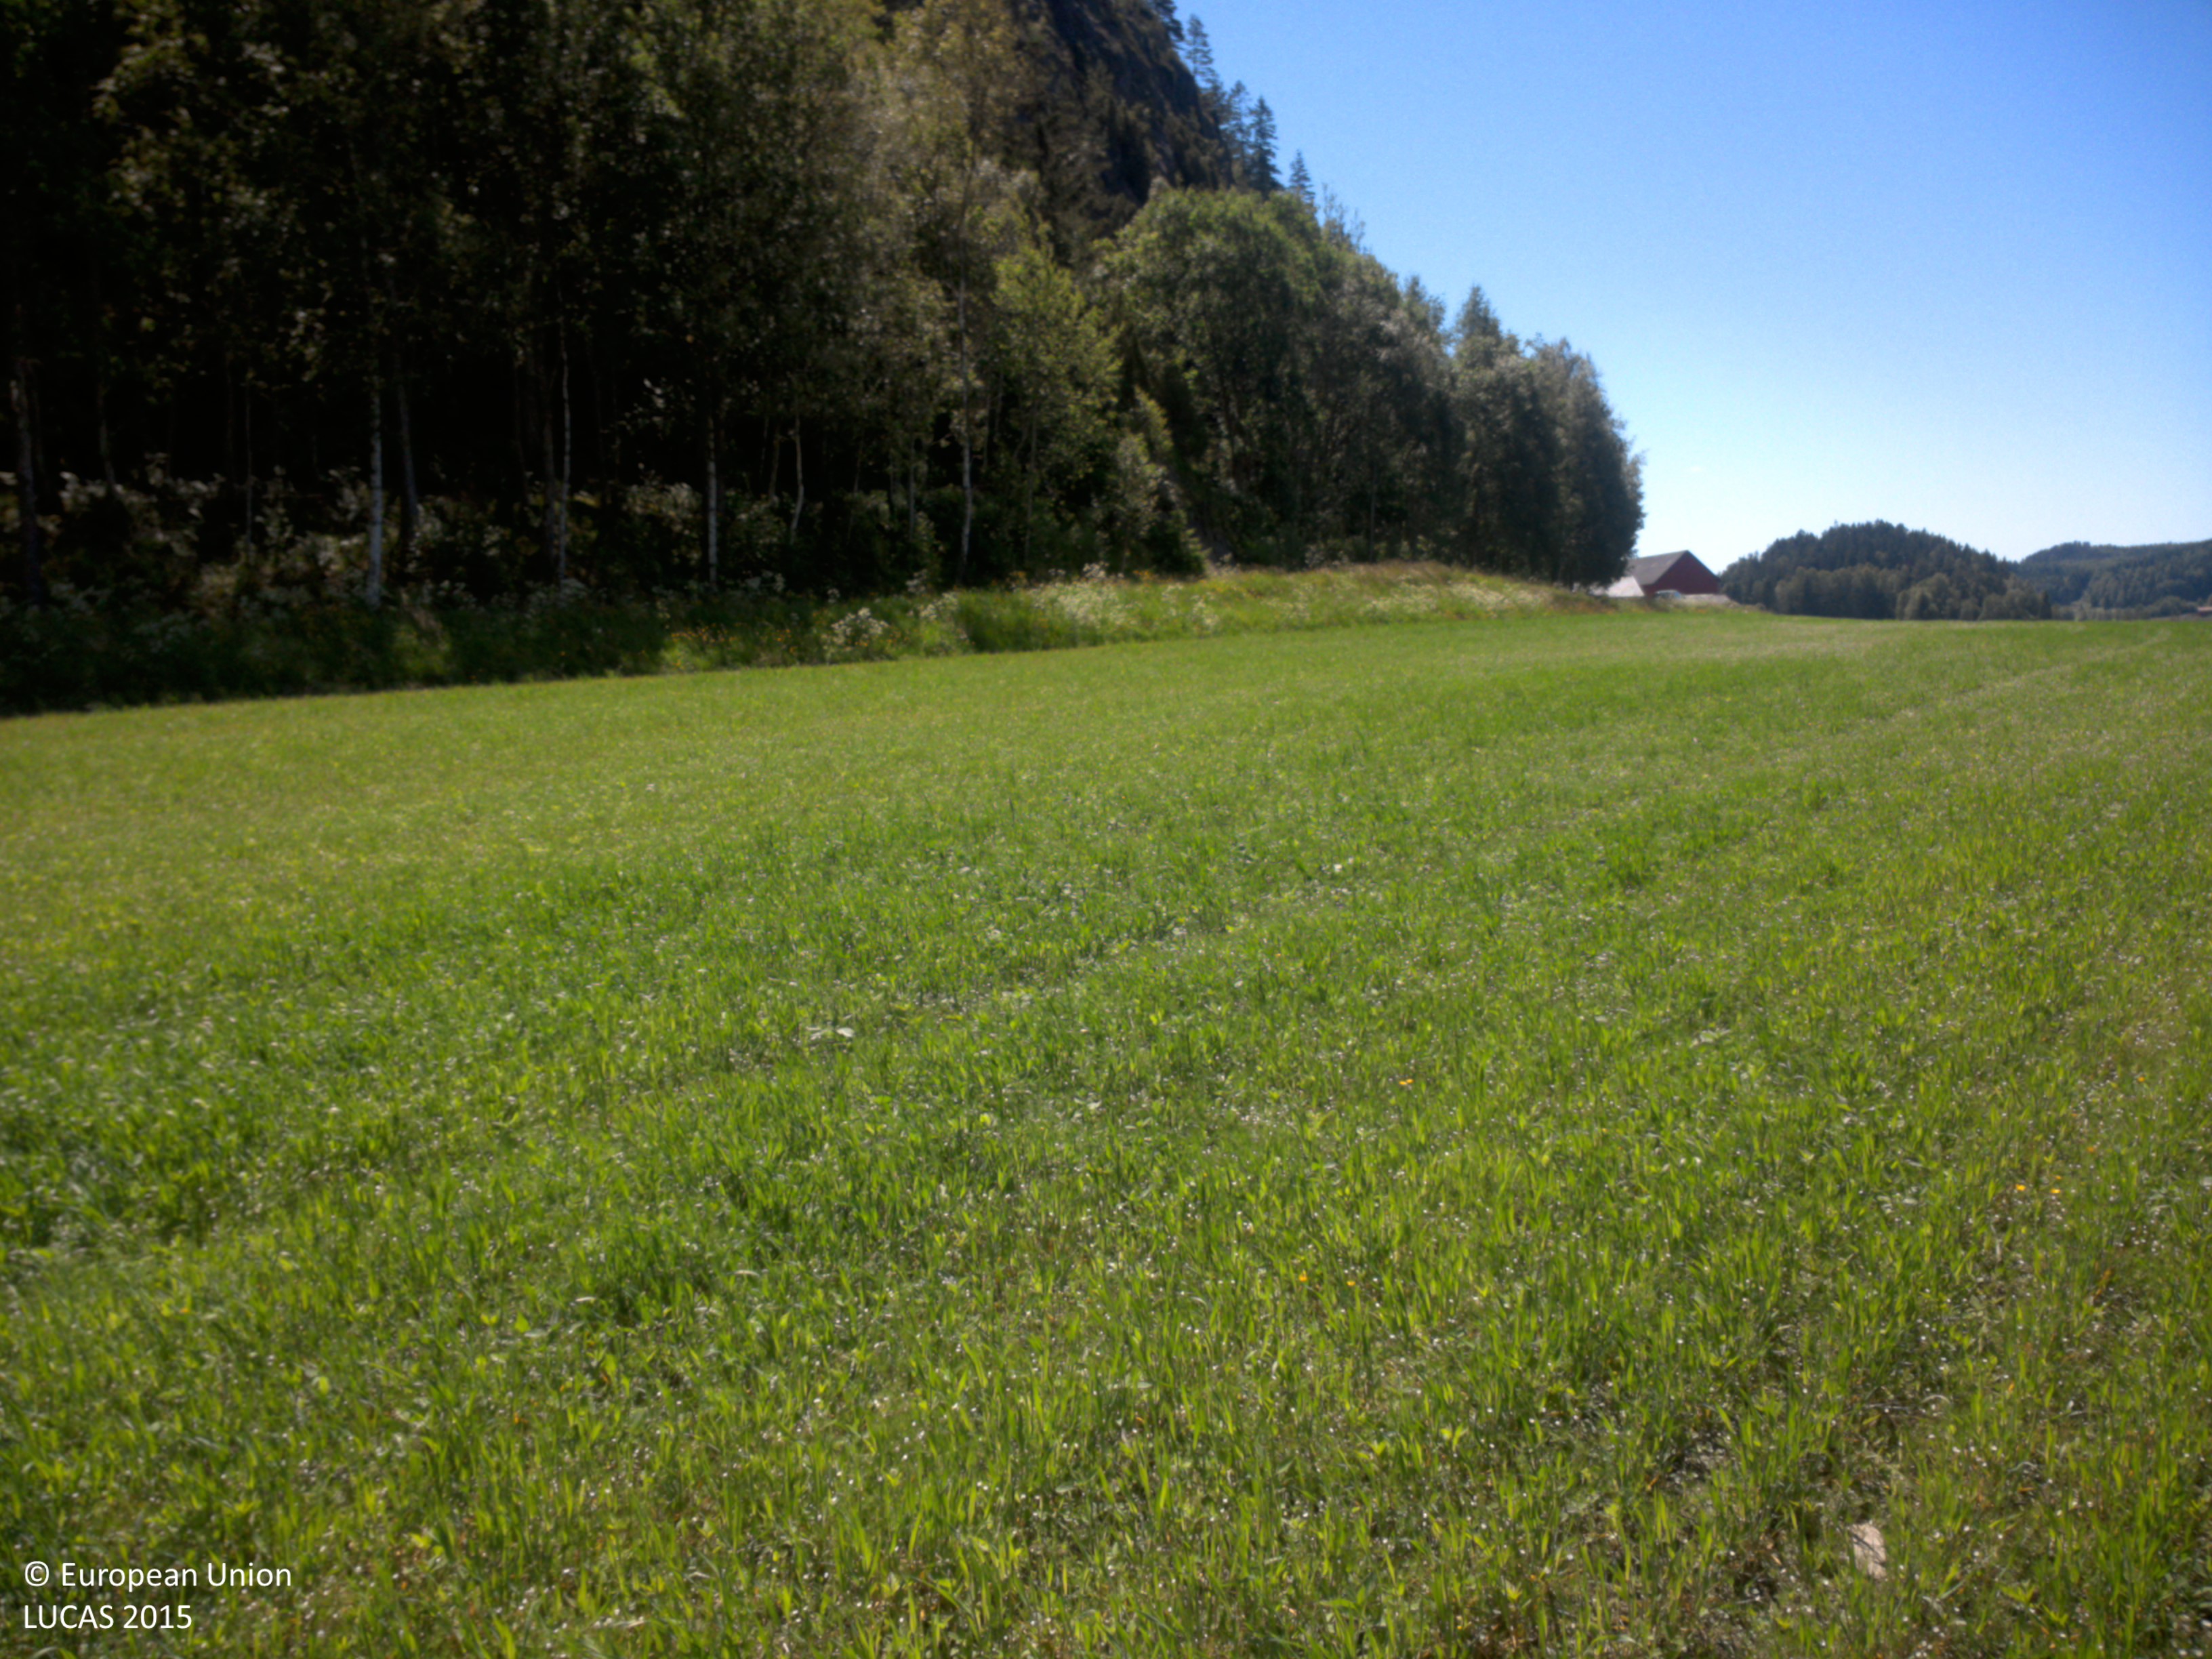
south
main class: Cropland
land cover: Triticale
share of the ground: > 75 %
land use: Agriculture (excluding fallow land and kitchen gardens)
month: June
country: SE
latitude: 58.5346
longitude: 11.5254
